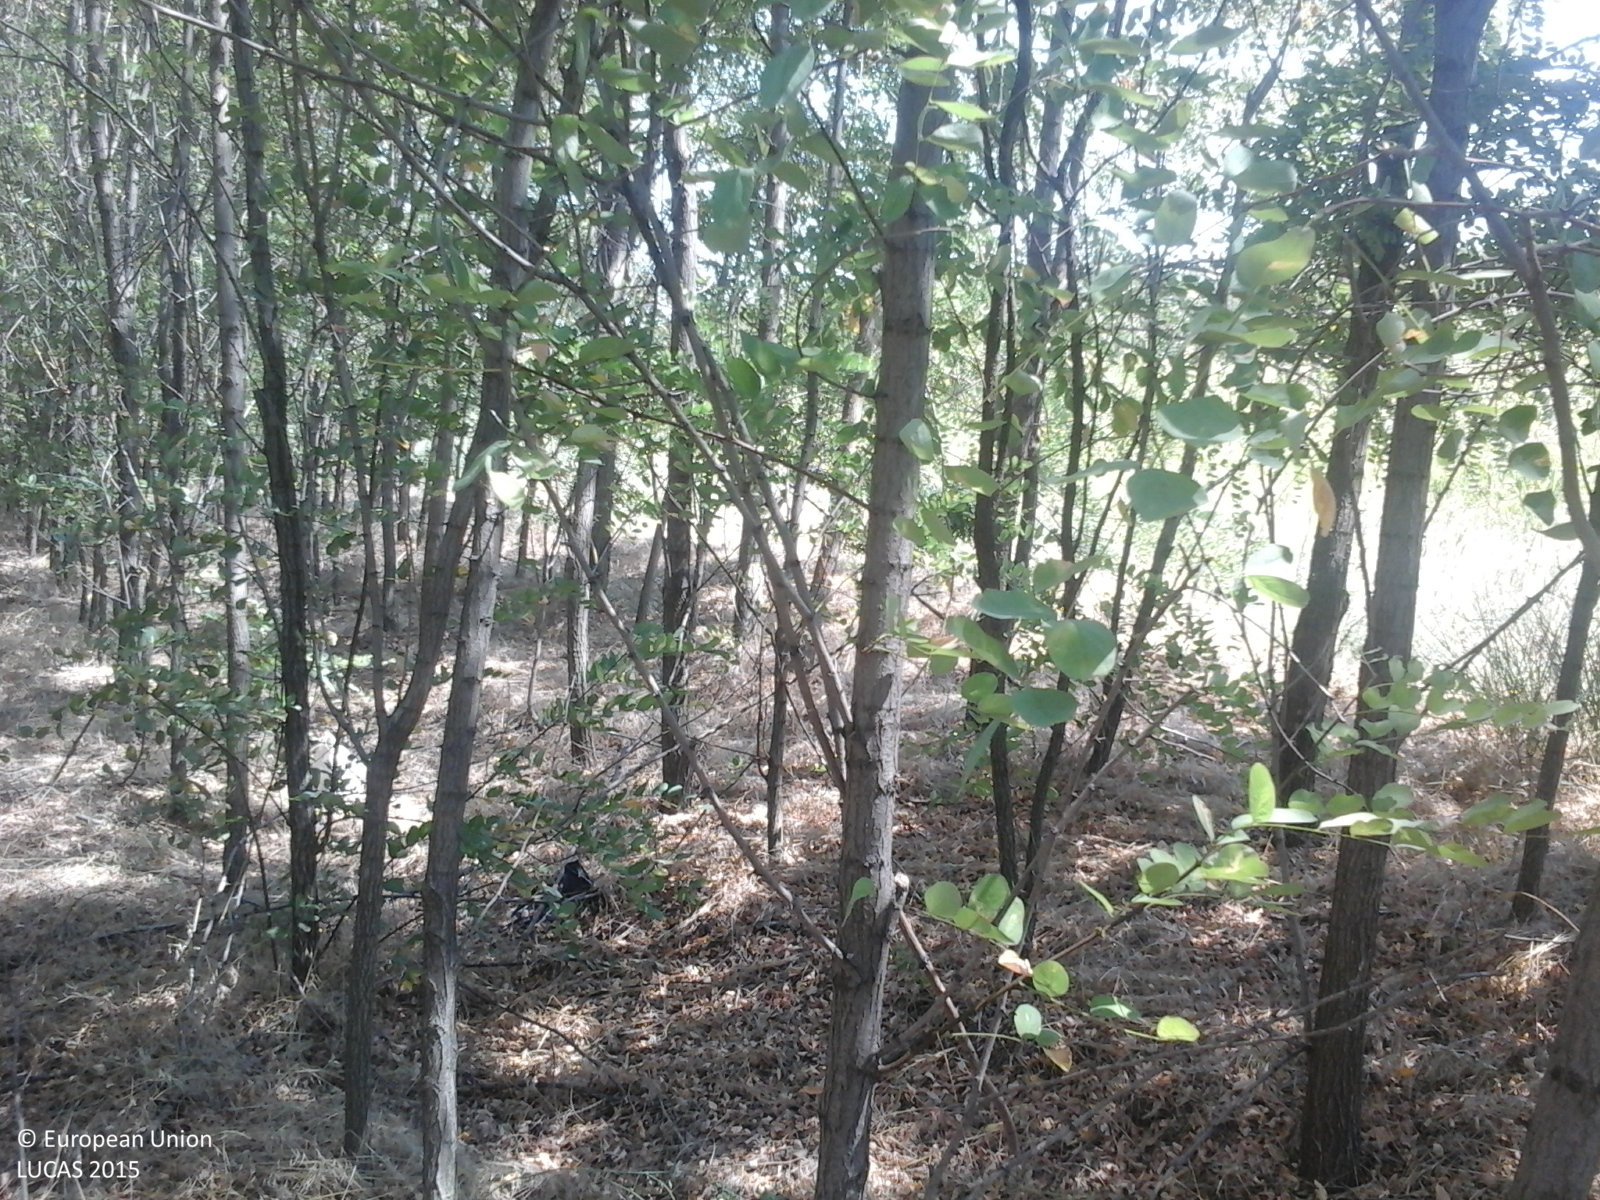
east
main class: Woodland
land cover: Broadleaved woodland
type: exotic forest
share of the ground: > 75 %
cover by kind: broadleaved forest trees 100 %
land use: Forestry
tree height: > 5 m
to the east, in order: Broadleaved woodland; Grass margins; Maize; Grass margins; Tracks; Grass margins; Sunflower
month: August
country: RO
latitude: 45.8160
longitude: 27.4920
